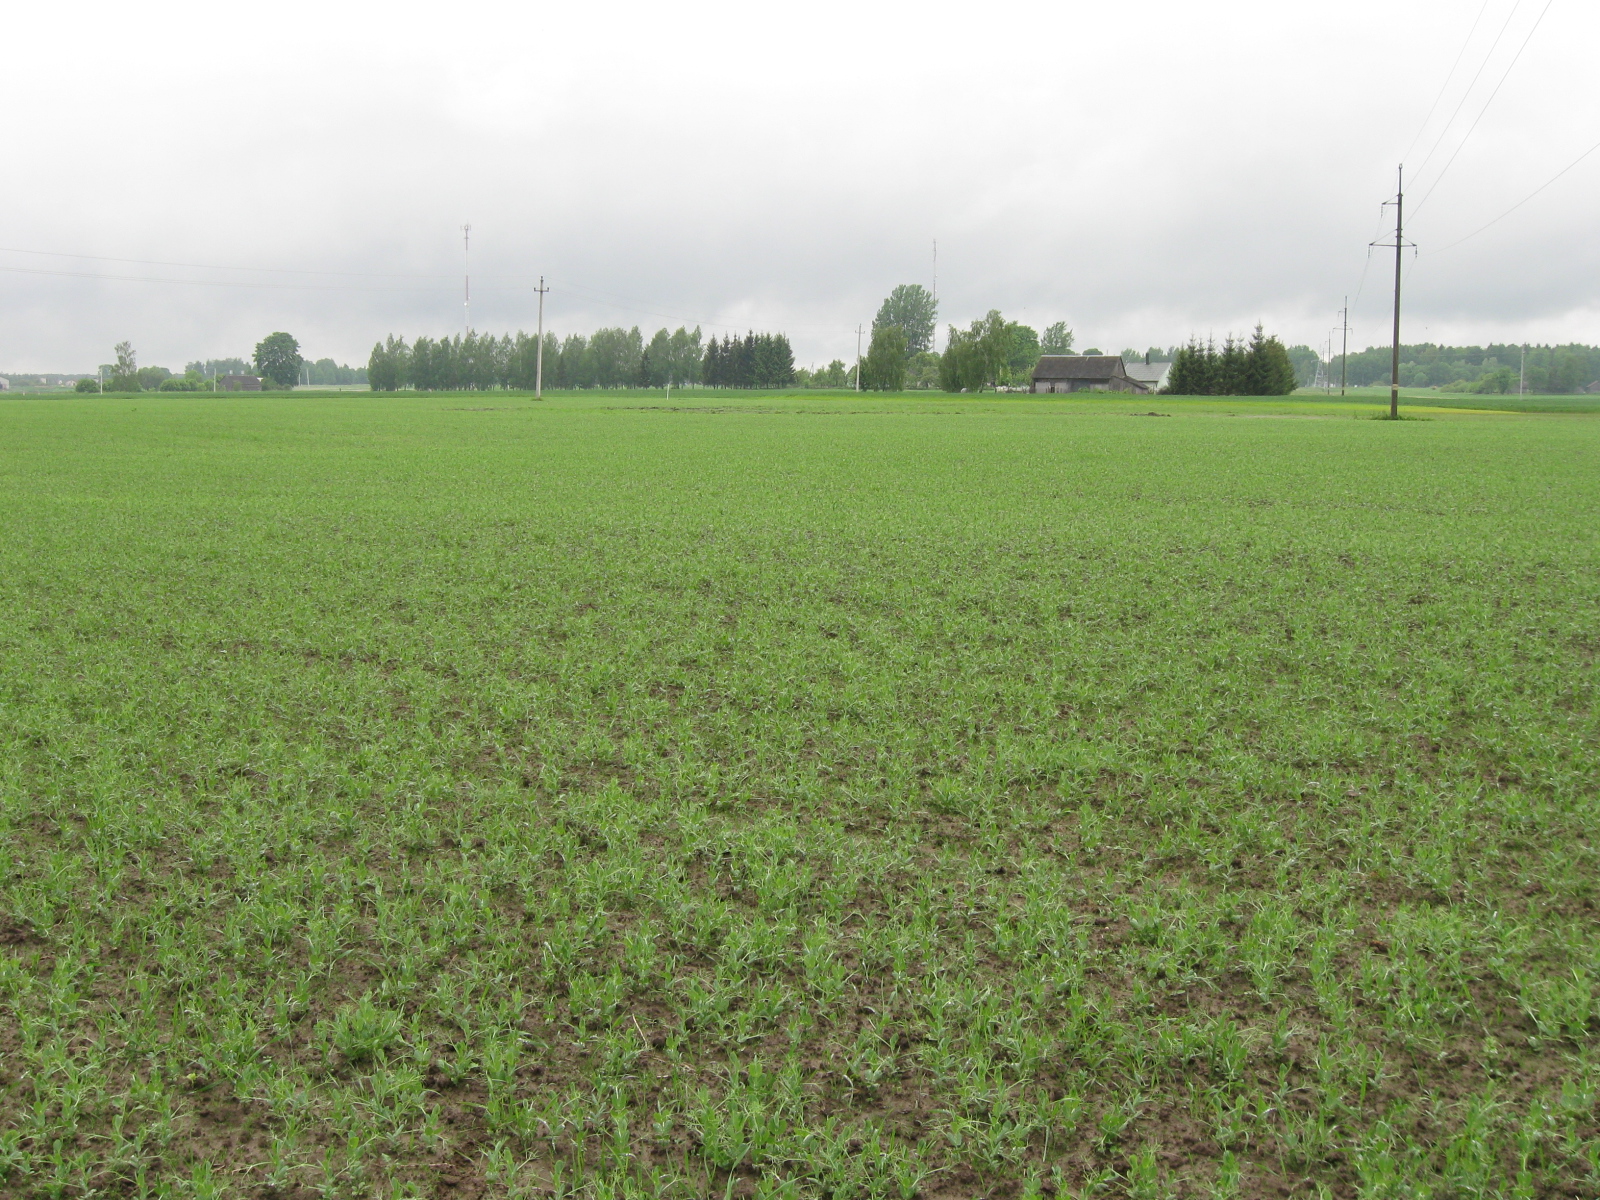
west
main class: Cropland
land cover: Dry pulses
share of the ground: > 75 %
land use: Agriculture (excluding fallow land and kitchen gardens)
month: May
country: LT
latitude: 54.9636
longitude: 22.7653
